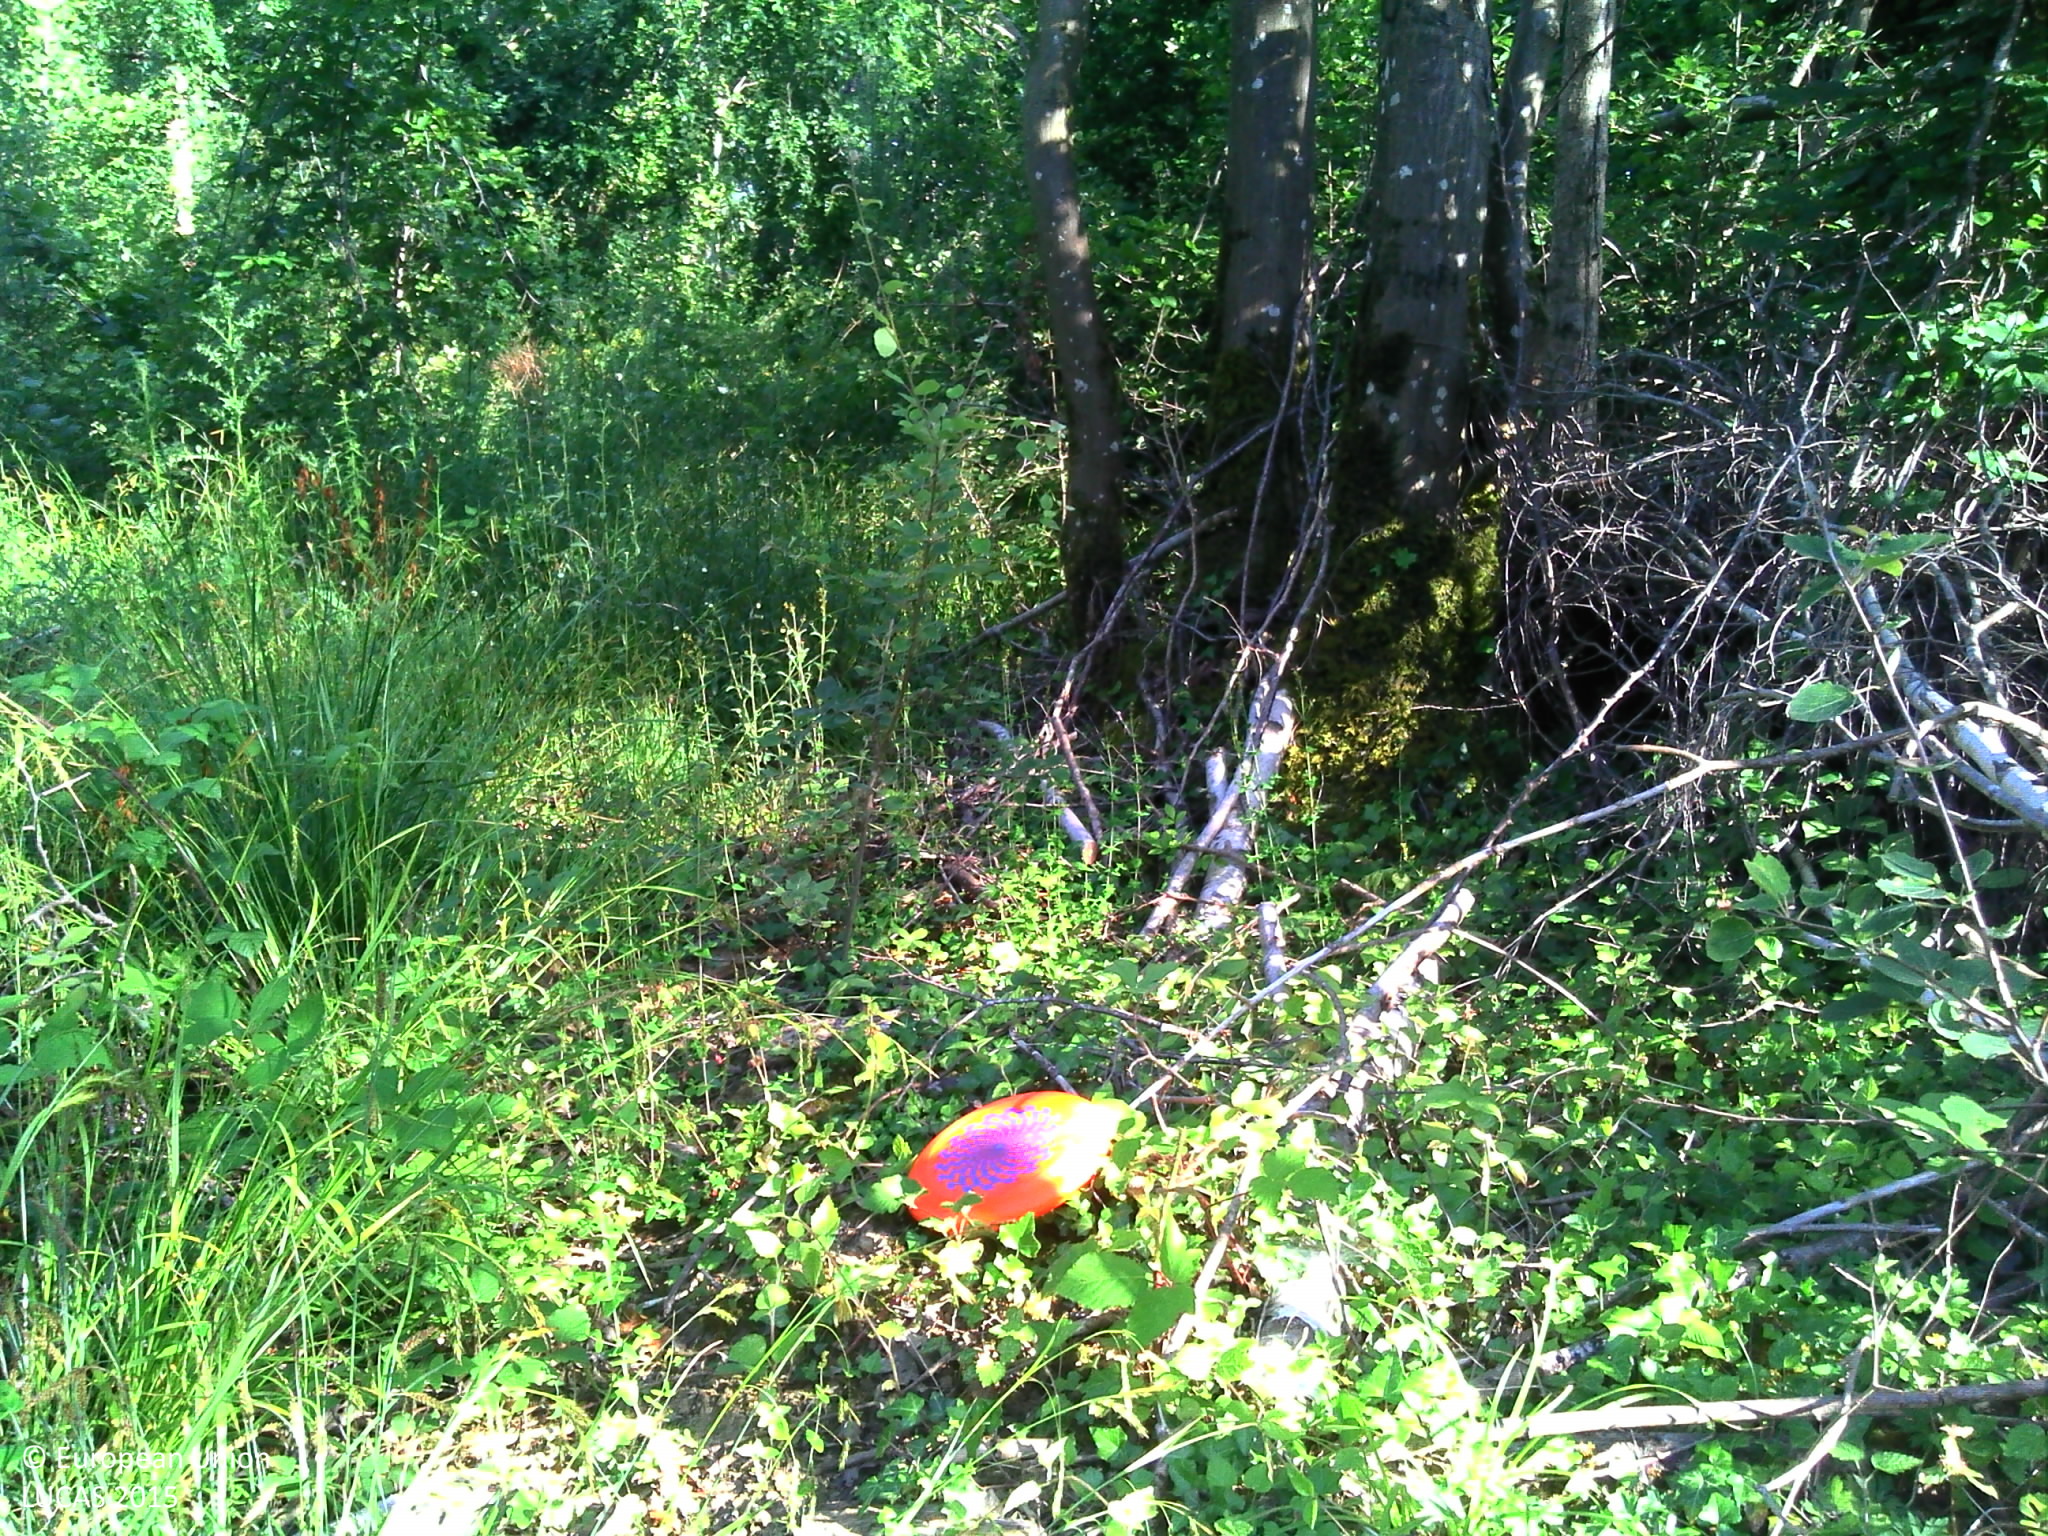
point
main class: Woodland
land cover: Broadleaved woodland
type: acidophilous oak and oak-birch forest
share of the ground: > 75 %
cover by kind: broadleaved forest trees 95 %, lichens and mosses 5 %
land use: Forestry
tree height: > 5 m
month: June
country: FR
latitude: 48.5452
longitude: 0.1785
